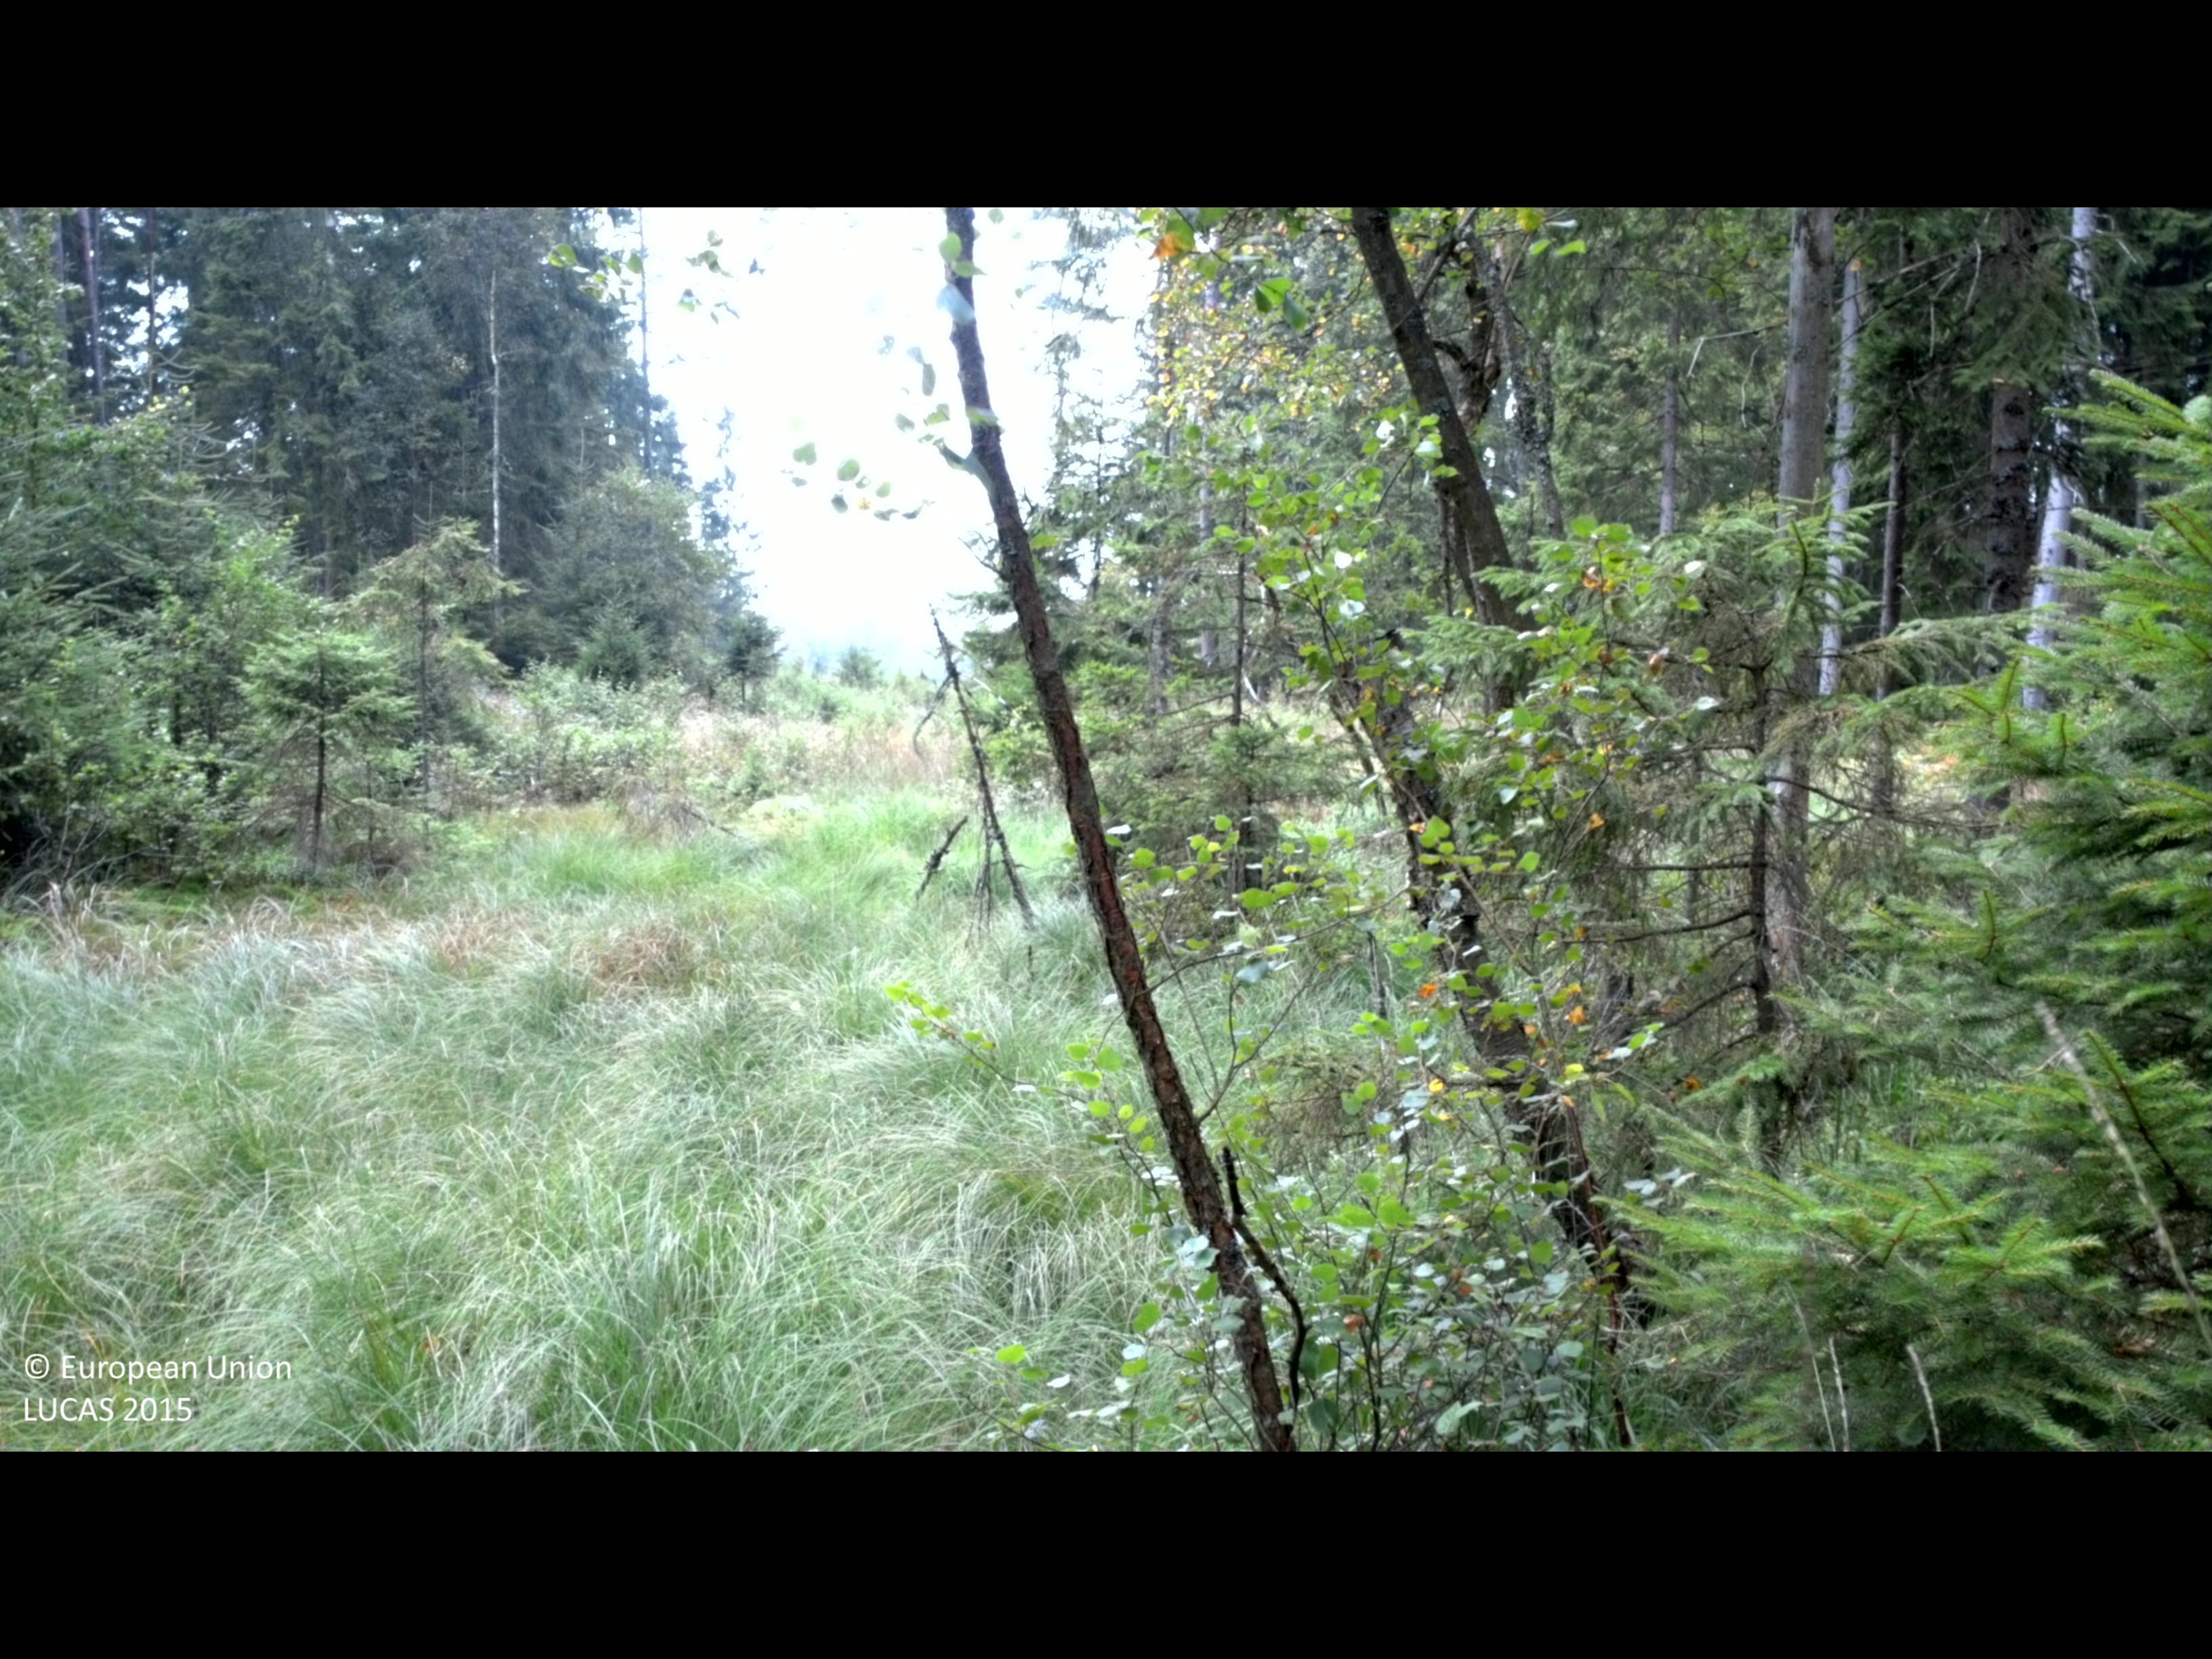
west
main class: Grassland
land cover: Grassland with sparse tree/shrub cover
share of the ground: > 75 %
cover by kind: herbaceous plants 90 %, broadleaved forest trees 5 %, shrubs 5 %
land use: Forestry
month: August
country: SE
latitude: 56.8490
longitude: 13.2266
